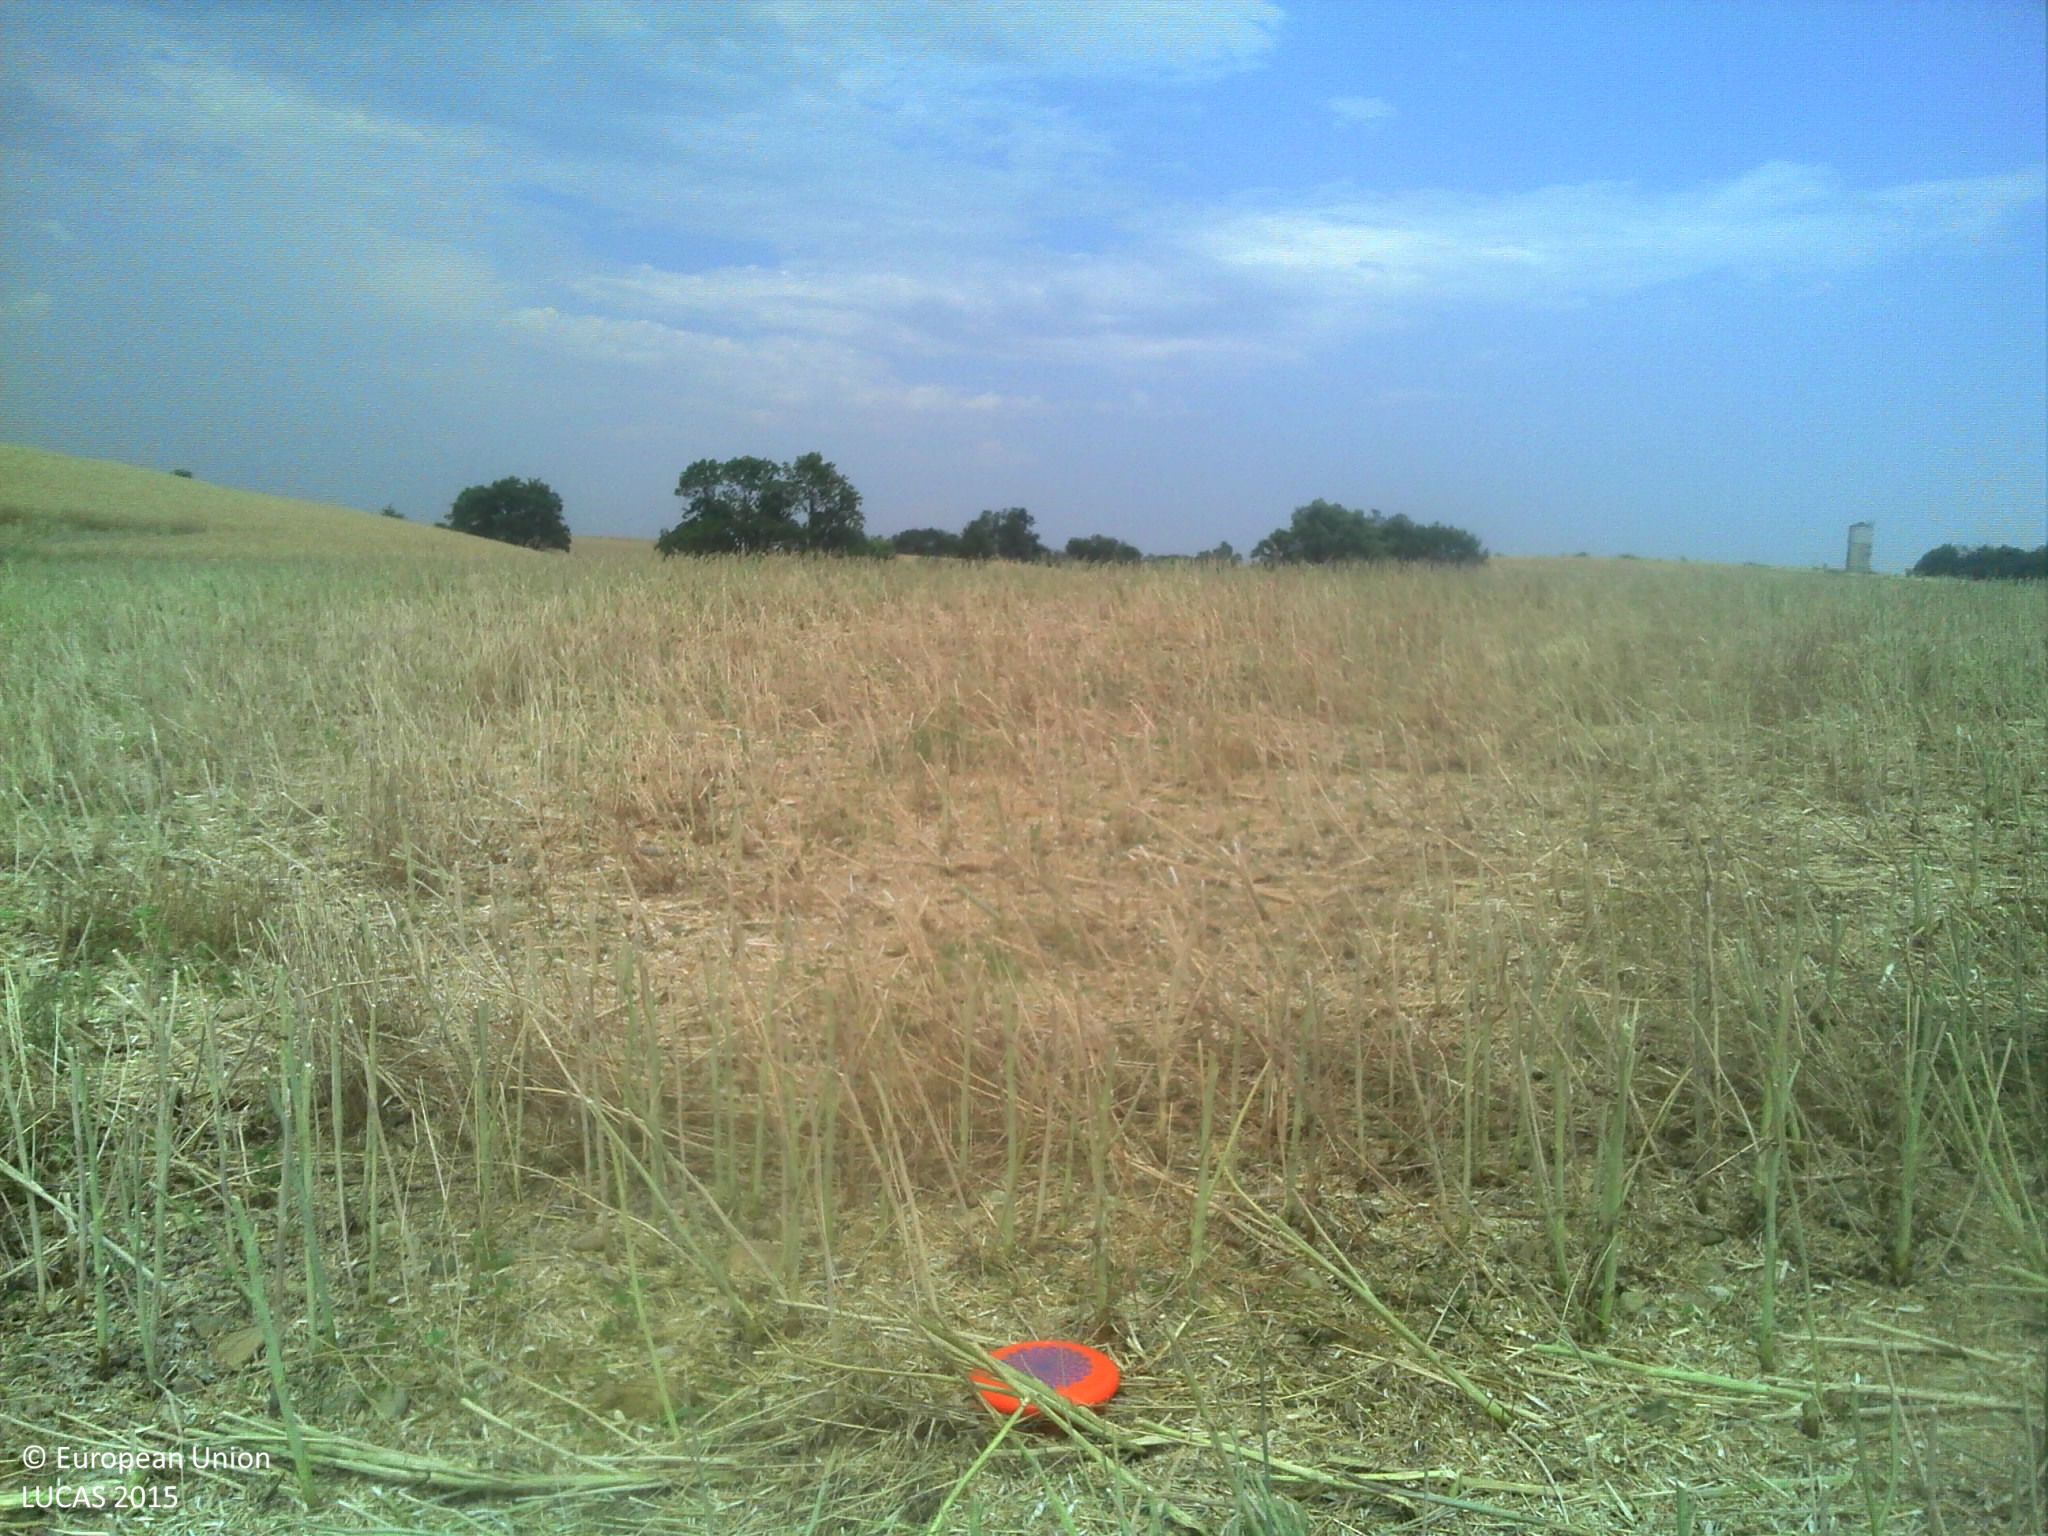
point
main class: Cropland
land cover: Rape and turnip rape
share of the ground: > 75 %
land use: Agriculture (excluding fallow land and kitchen gardens)
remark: Harvested field
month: July
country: FR
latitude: 45.5554
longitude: 5.1493
